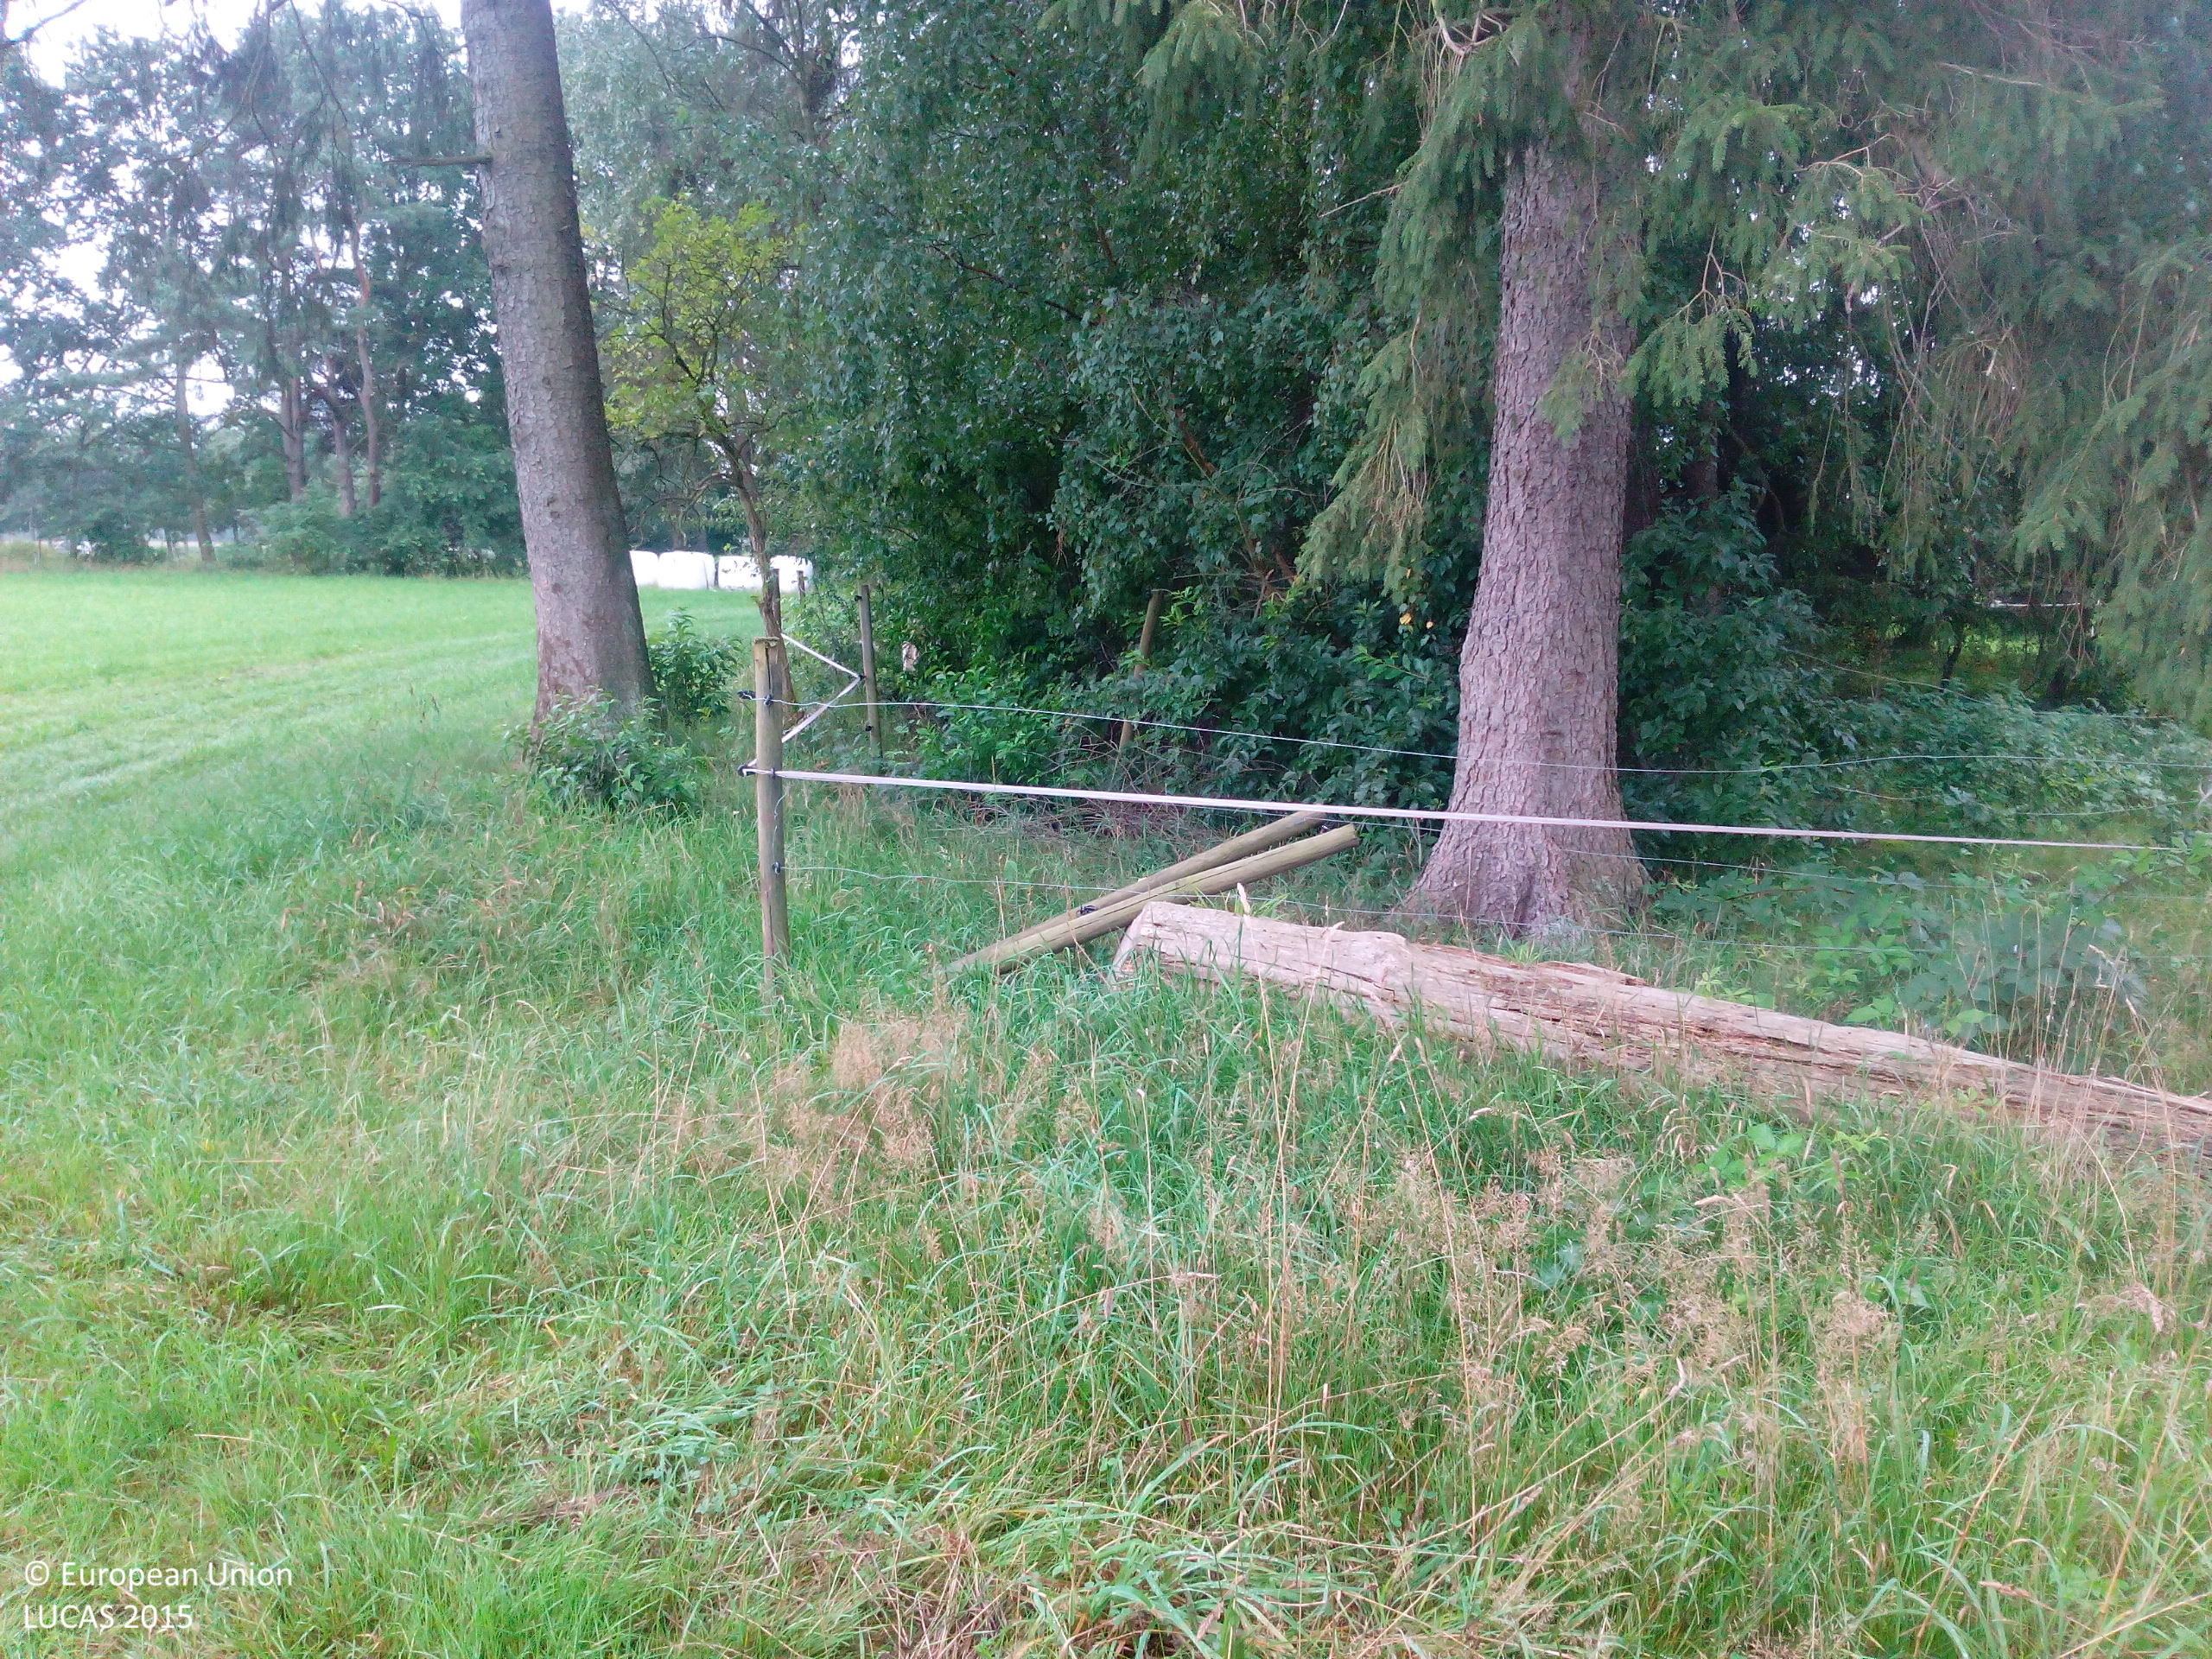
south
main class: Grassland
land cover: Grassland without tree/shrub cover
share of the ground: > 75 %
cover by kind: herbaceous plants 100 %
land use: Agriculture (excluding fallow land and kitchen gardens)
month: August
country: DE
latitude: 53.7254
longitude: 9.9546
